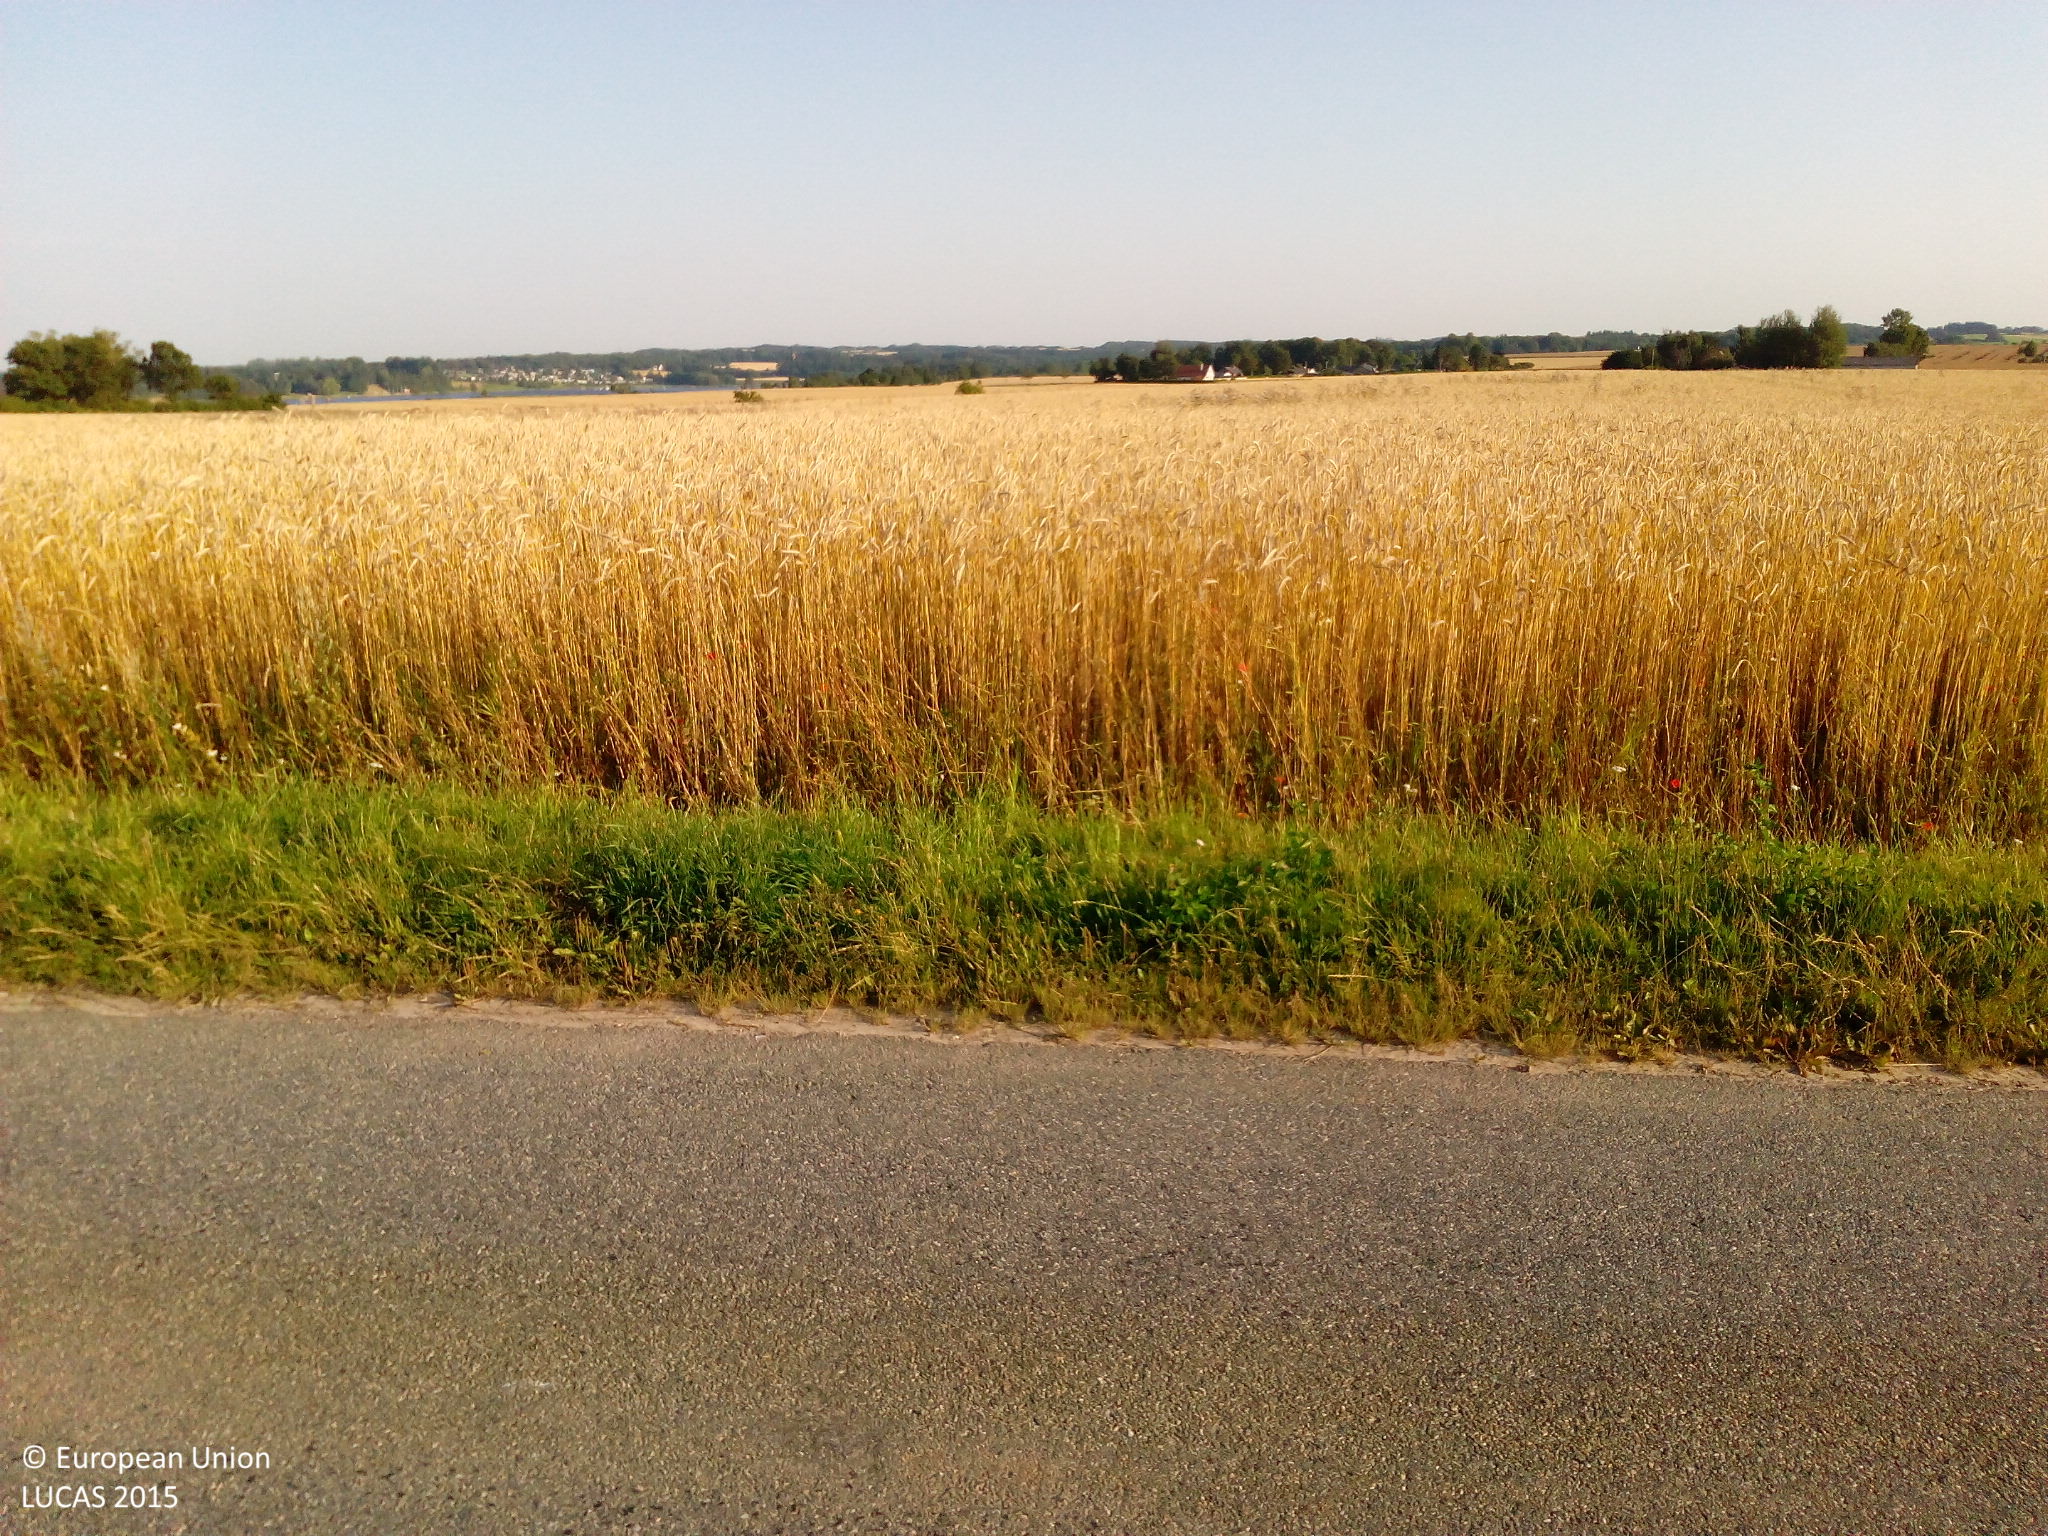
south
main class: Cropland
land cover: Oats
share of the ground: > 75 %
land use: Agriculture (excluding fallow land and kitchen gardens)
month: August
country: DK
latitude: 55.6699
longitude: 11.9221
